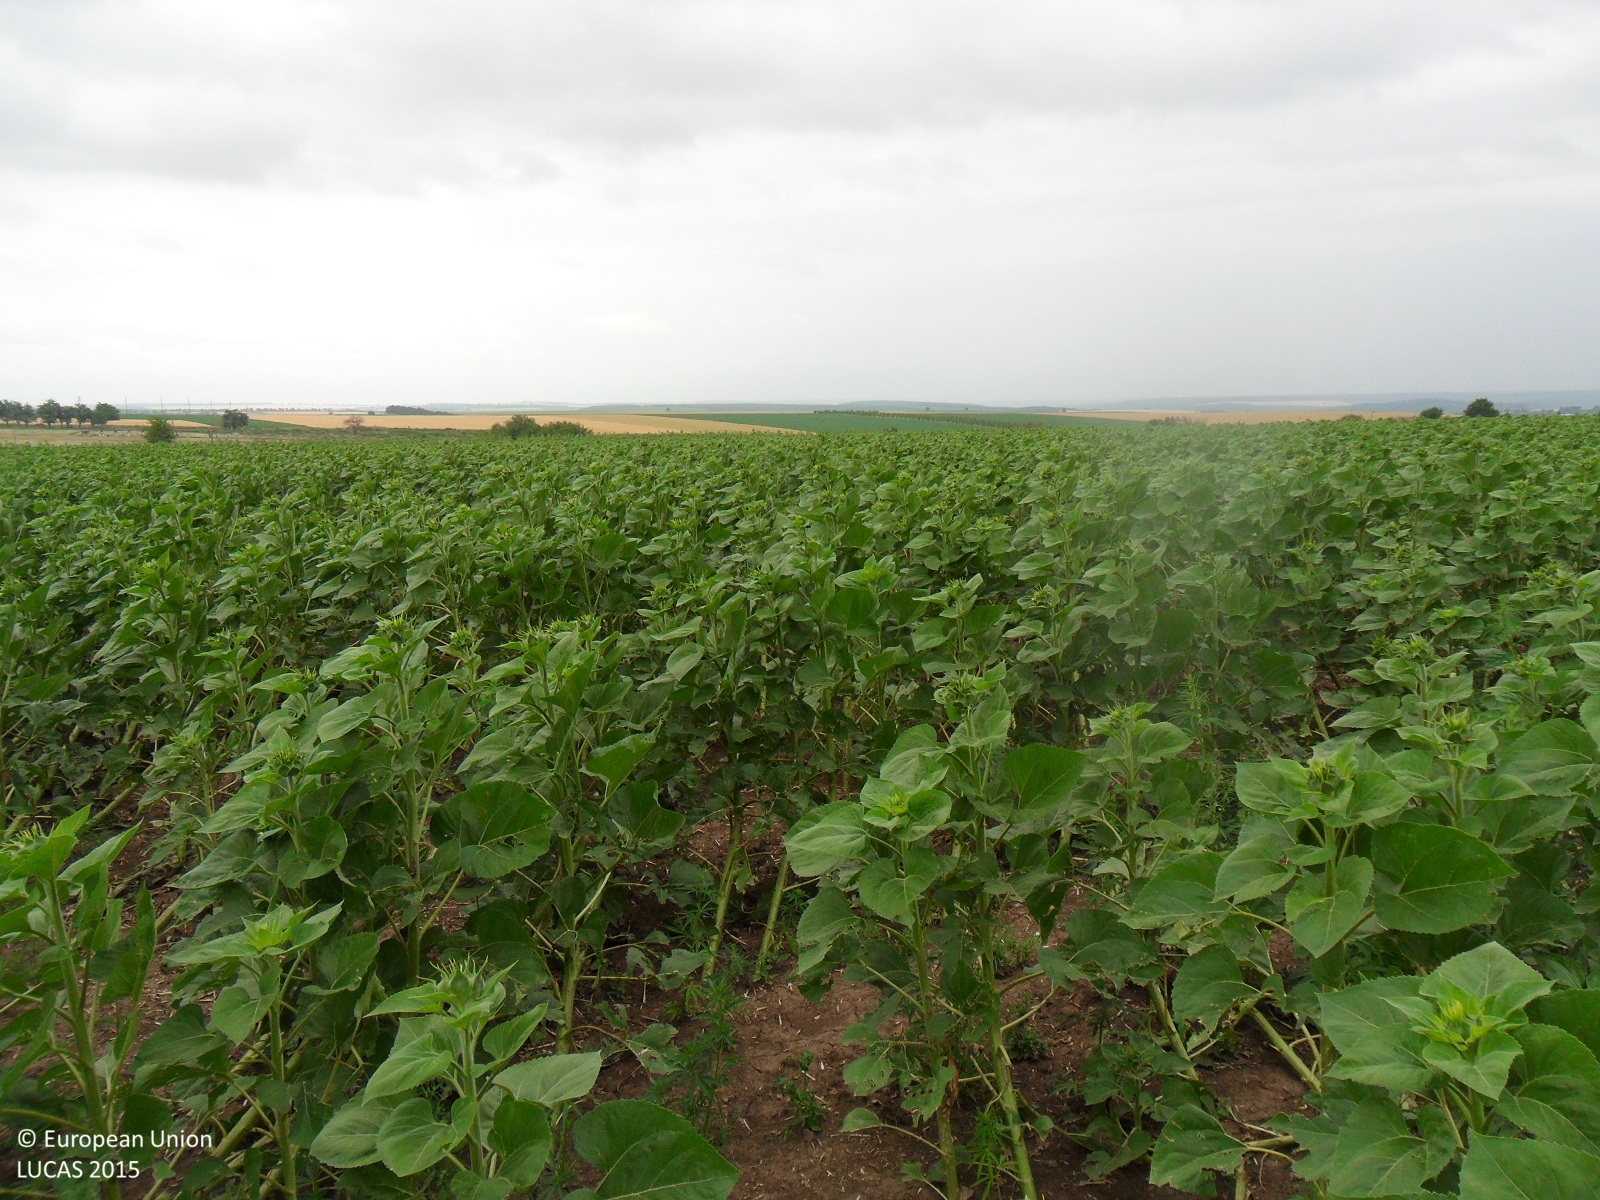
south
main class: Cropland
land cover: Sunflower
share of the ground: > 75 %
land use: Agriculture (excluding fallow land and kitchen gardens)
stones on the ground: < 10 %
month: June
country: BG
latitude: 43.8130
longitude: 26.8122
